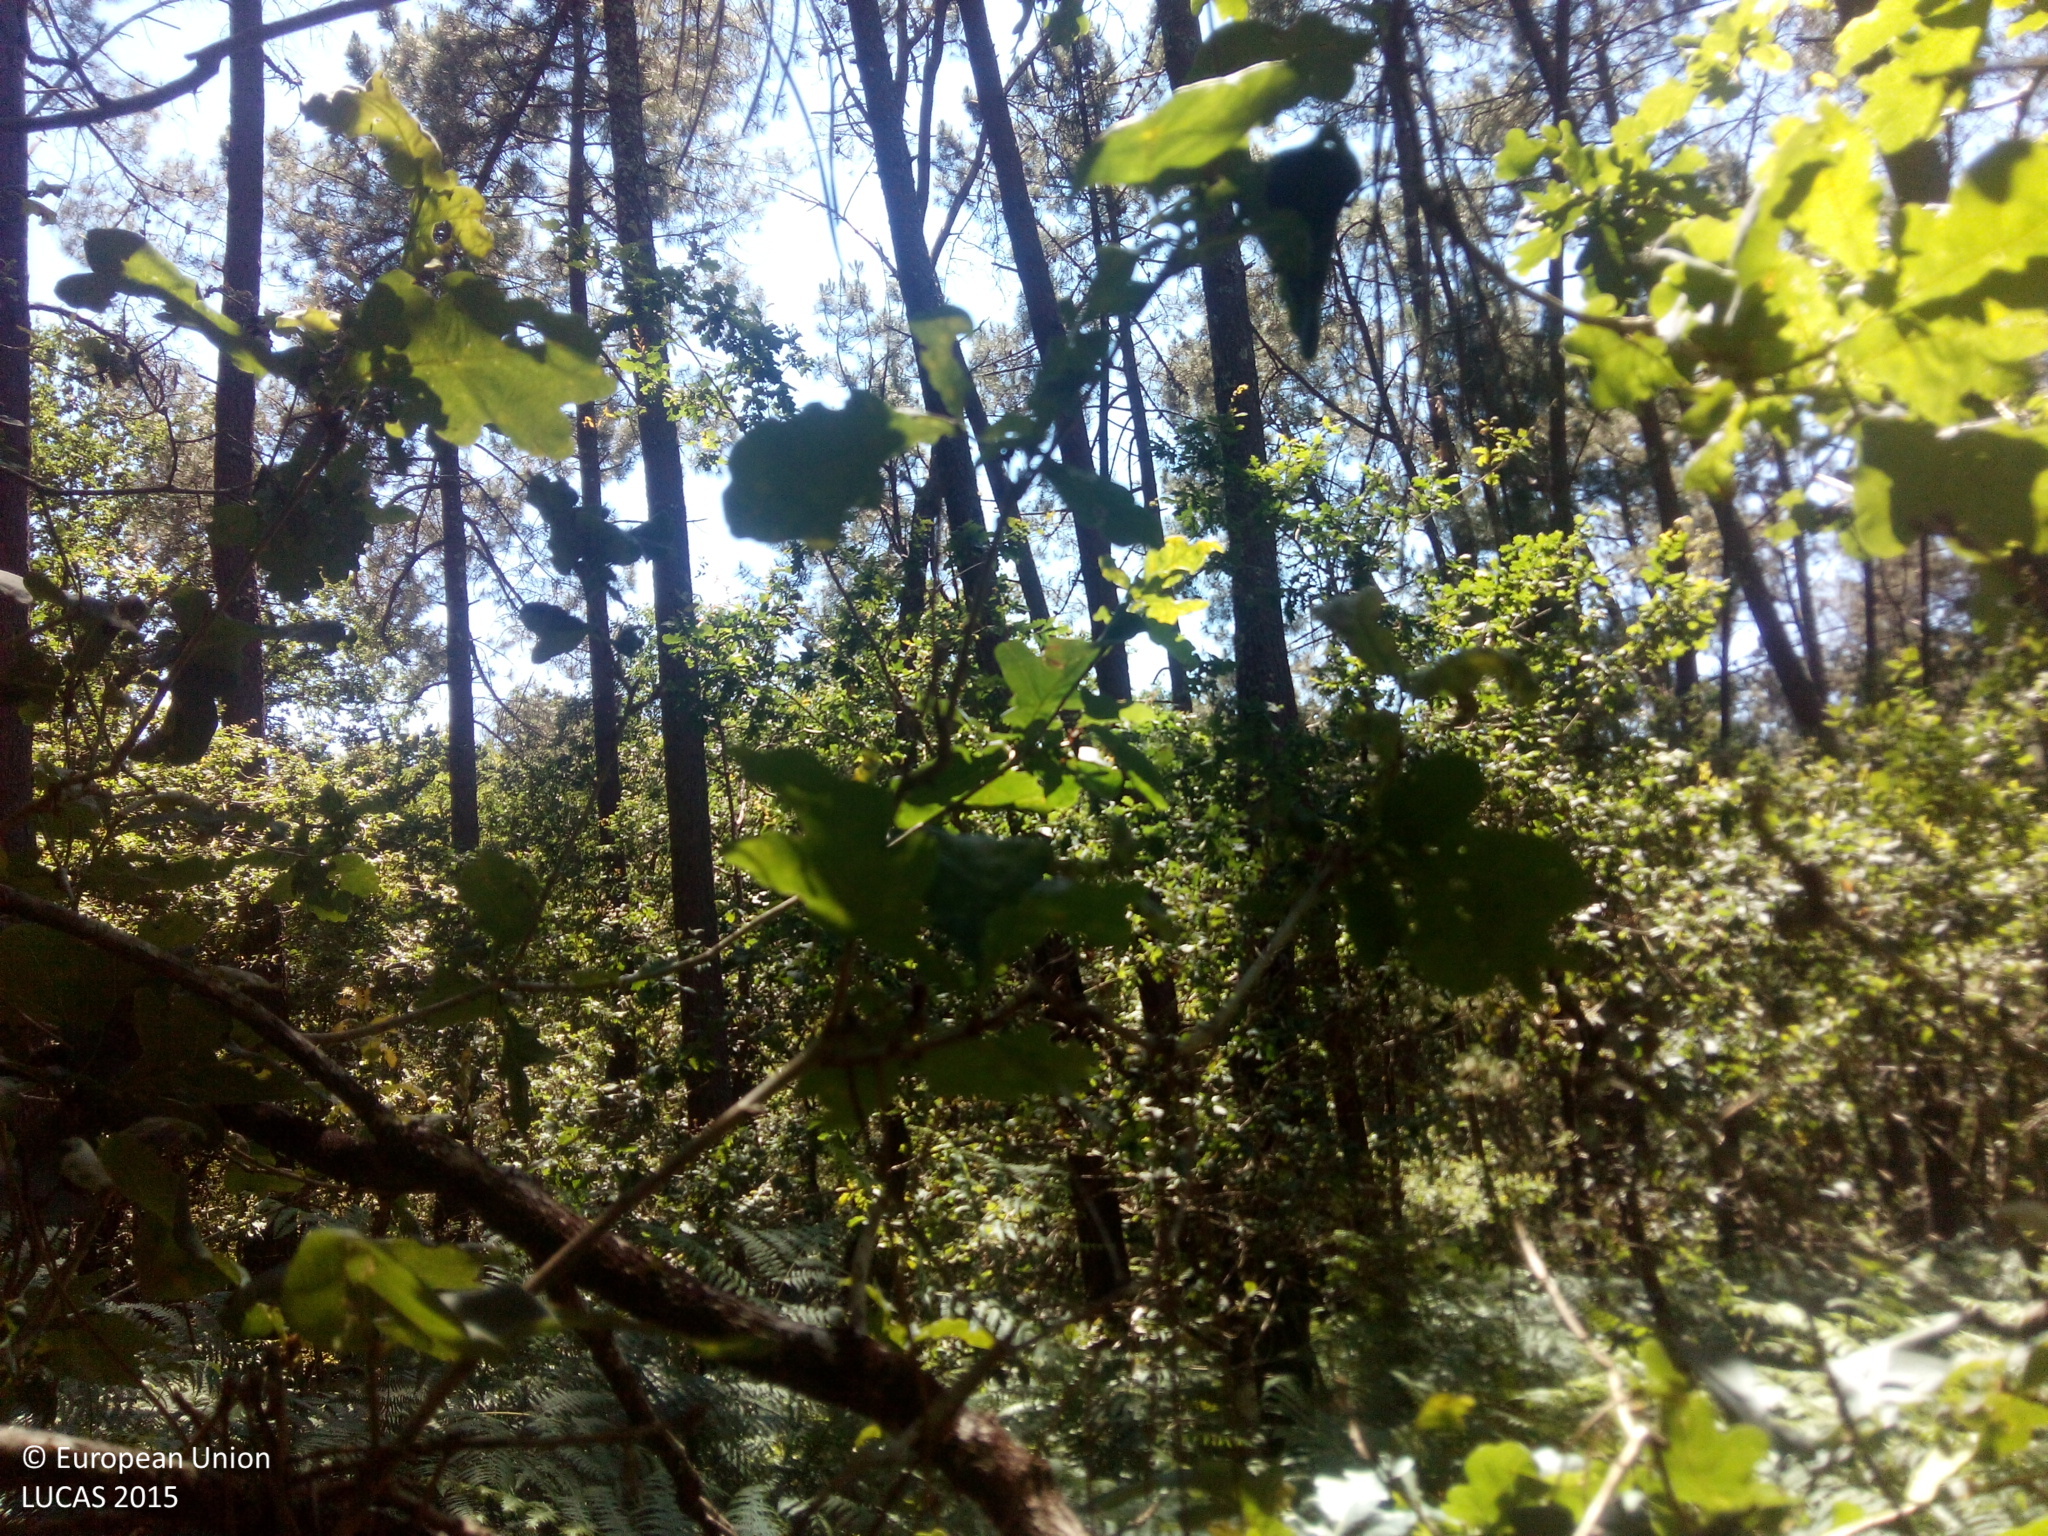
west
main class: Woodland
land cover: Pine dominated mixed woodland
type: hemiboreal forest and nemoral coniferous forest and mixed broadleaved-coniferous forest
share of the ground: > 75 %
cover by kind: coniferous forest trees 75 %, broadleaved forest trees 25 %
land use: Forestry
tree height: > 5 m
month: June
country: ES
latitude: 42.7367
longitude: -8.4337
